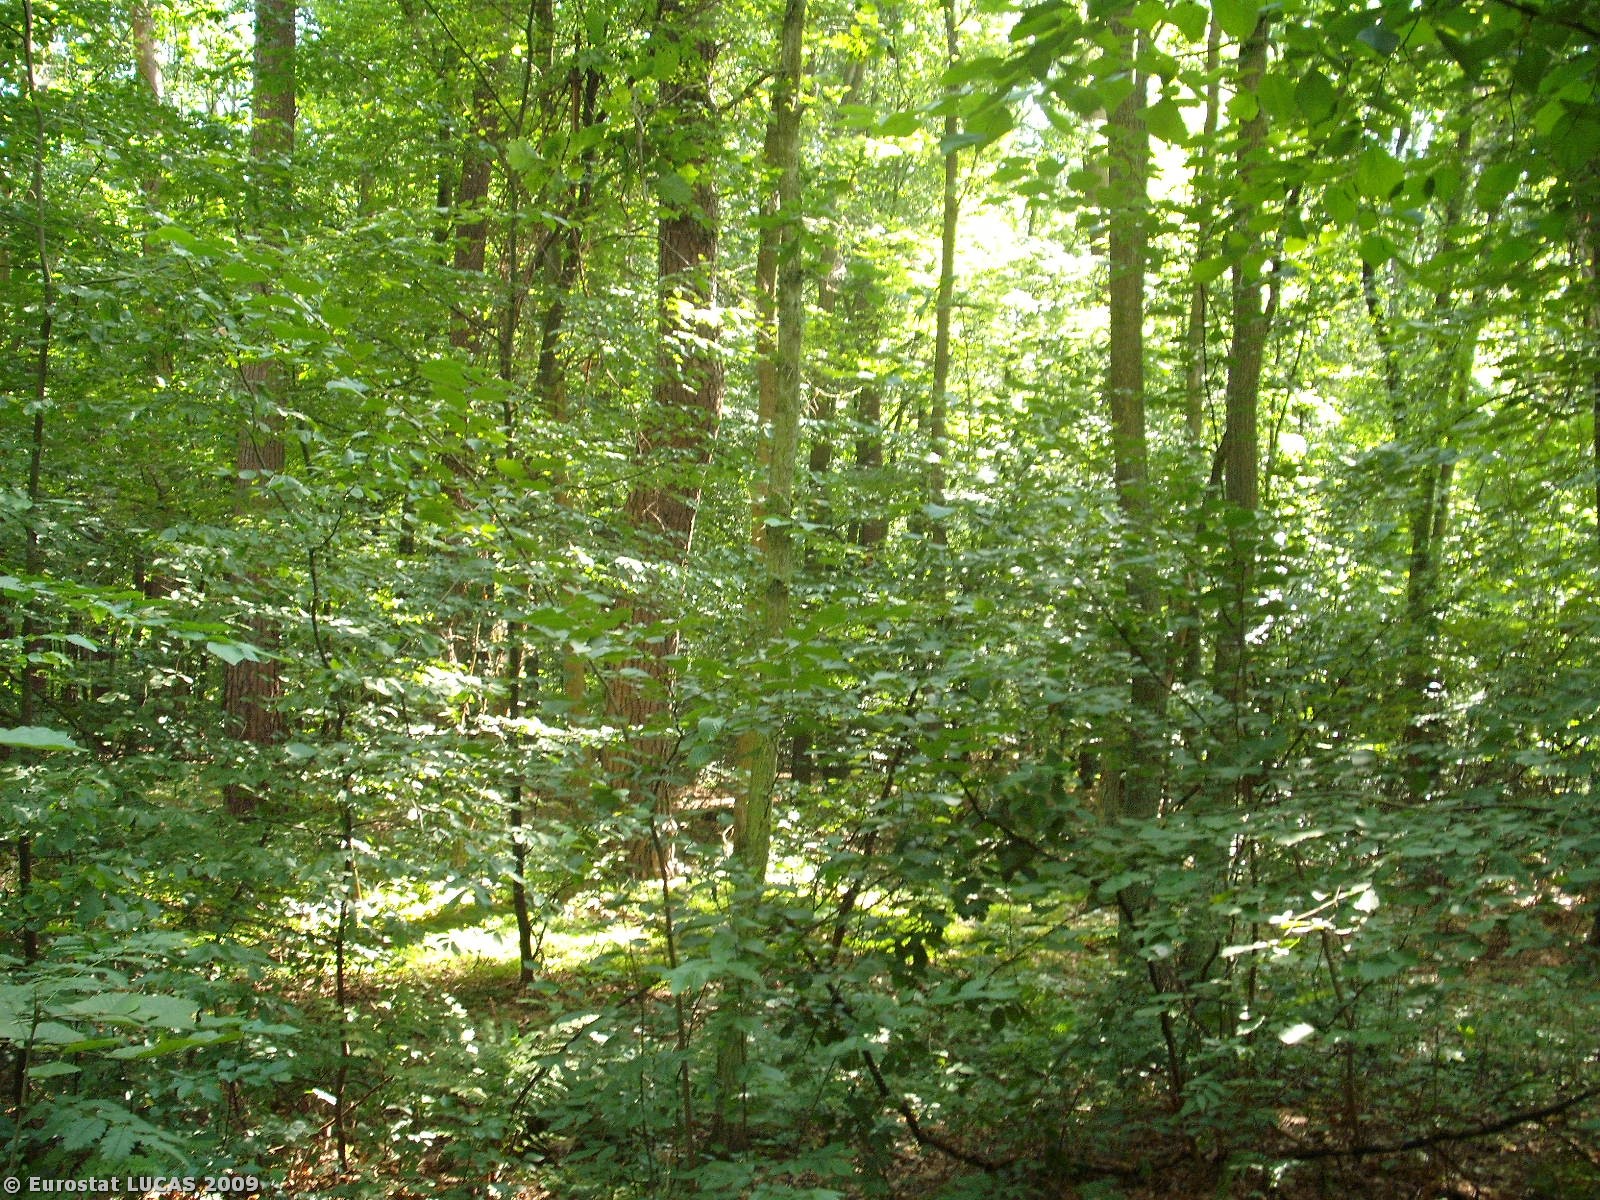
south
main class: Woodland
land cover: Mixed woodland
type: hemiboreal forest and nemoral coniferous forest and mixed broadleaved-coniferous forest
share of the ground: > 75 %
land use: Forestry
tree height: > 5 m
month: August
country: PL
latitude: 51.8111
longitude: 21.5542
